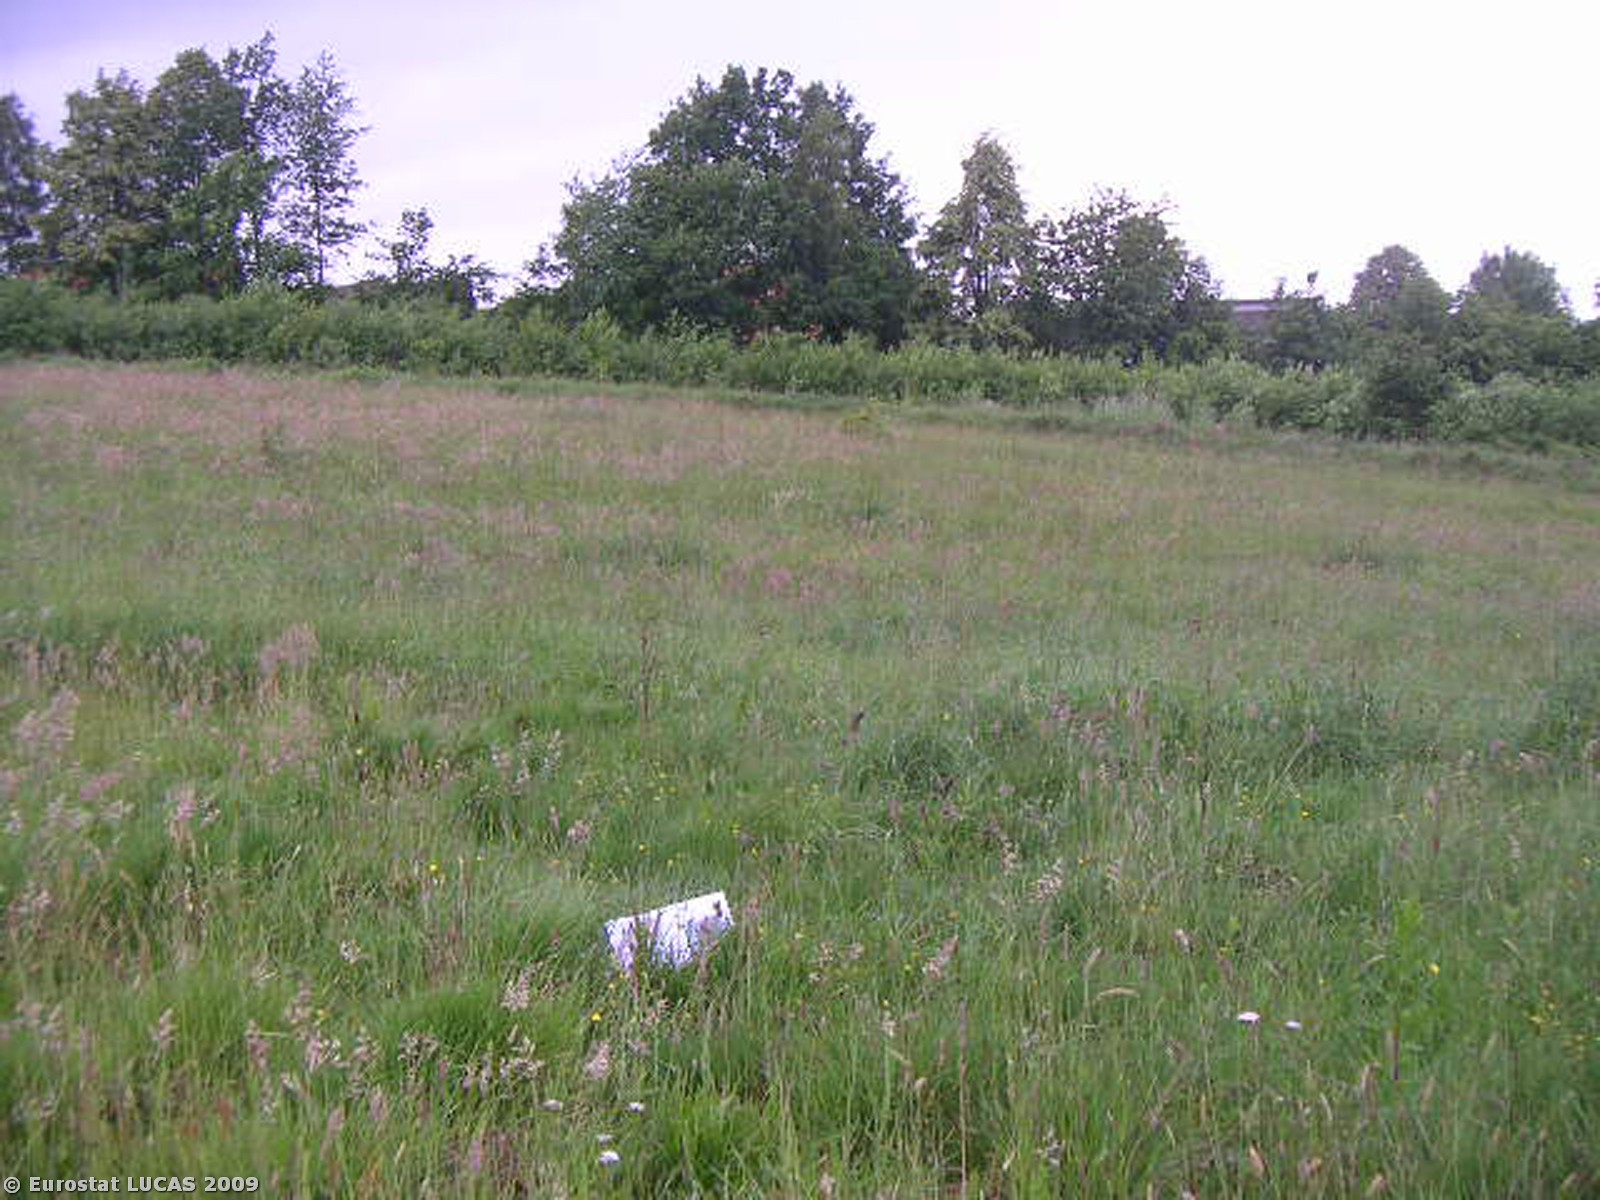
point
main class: Grassland
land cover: Grassland without tree/shrub cover
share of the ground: > 75 %
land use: Agriculture (excluding fallow land and kitchen gardens)
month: June
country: PL
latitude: 49.9032
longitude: 19.6213
